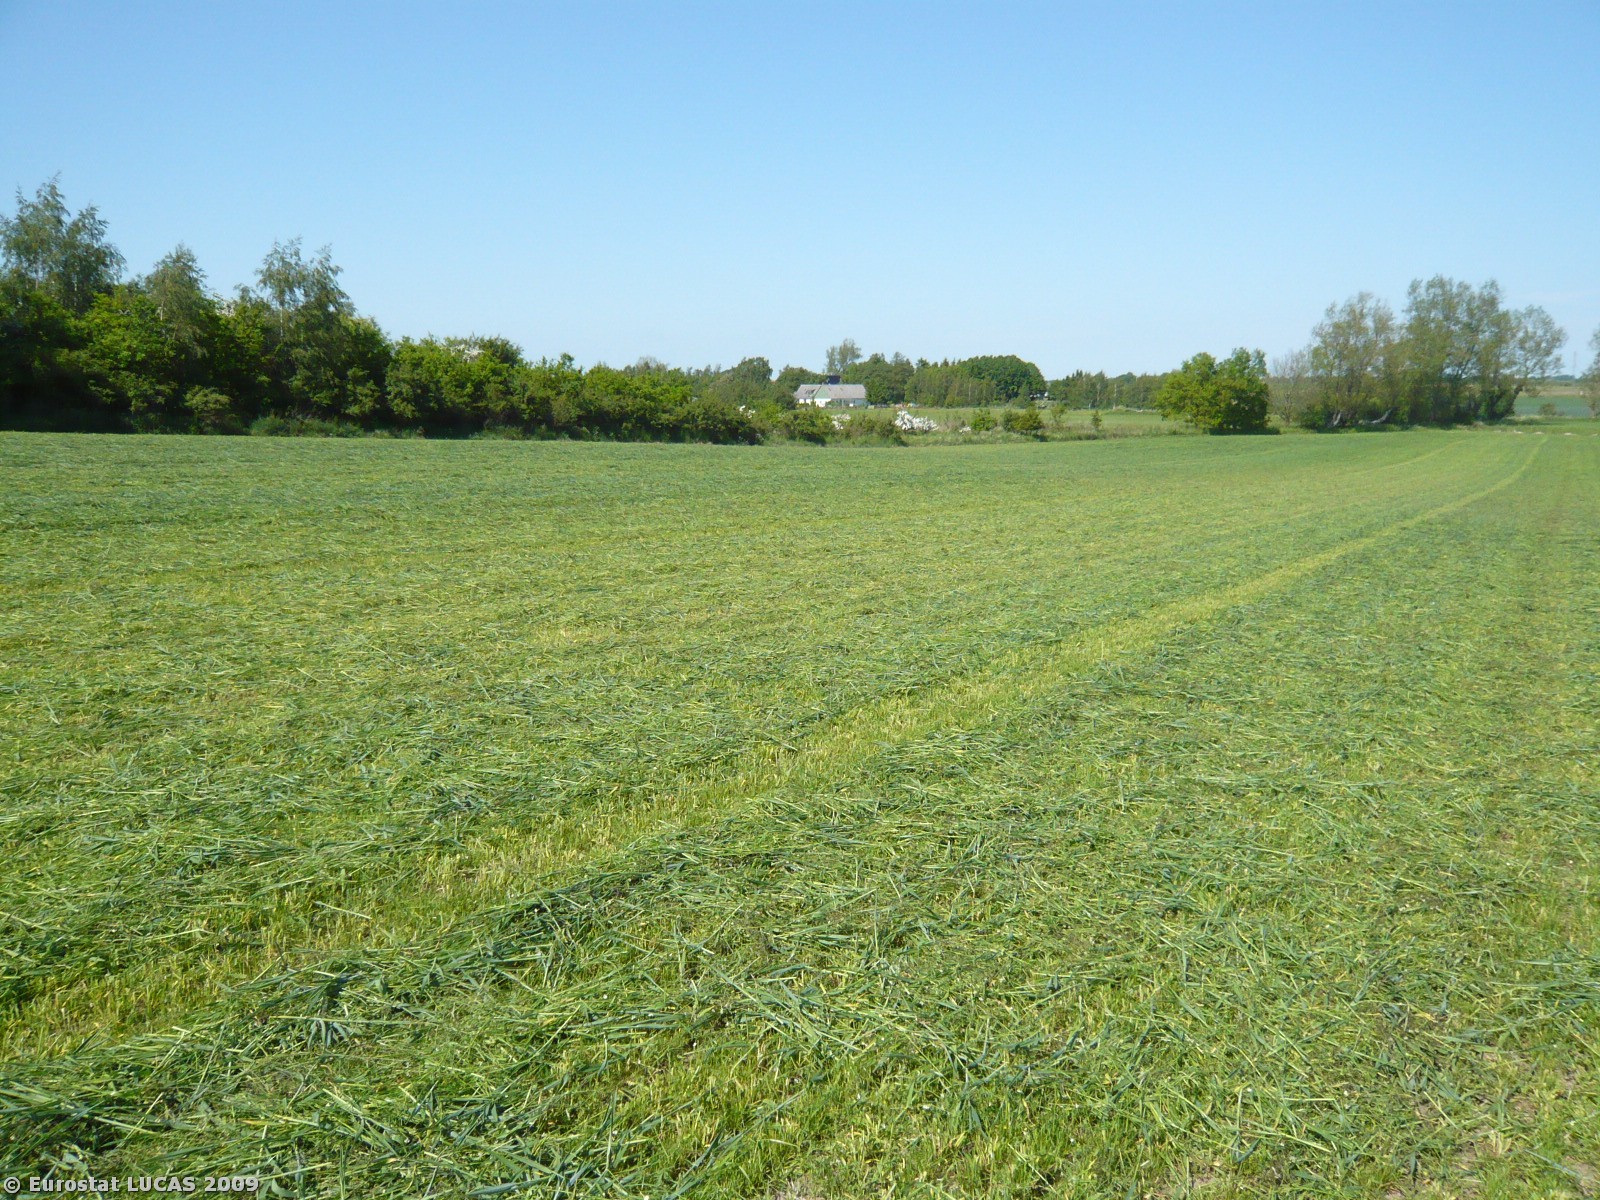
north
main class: Grassland
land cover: Grassland without tree/shrub cover
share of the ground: > 75 %
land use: Agriculture (excluding fallow land and kitchen gardens)
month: May
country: DK
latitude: 55.2774
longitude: 11.7145
